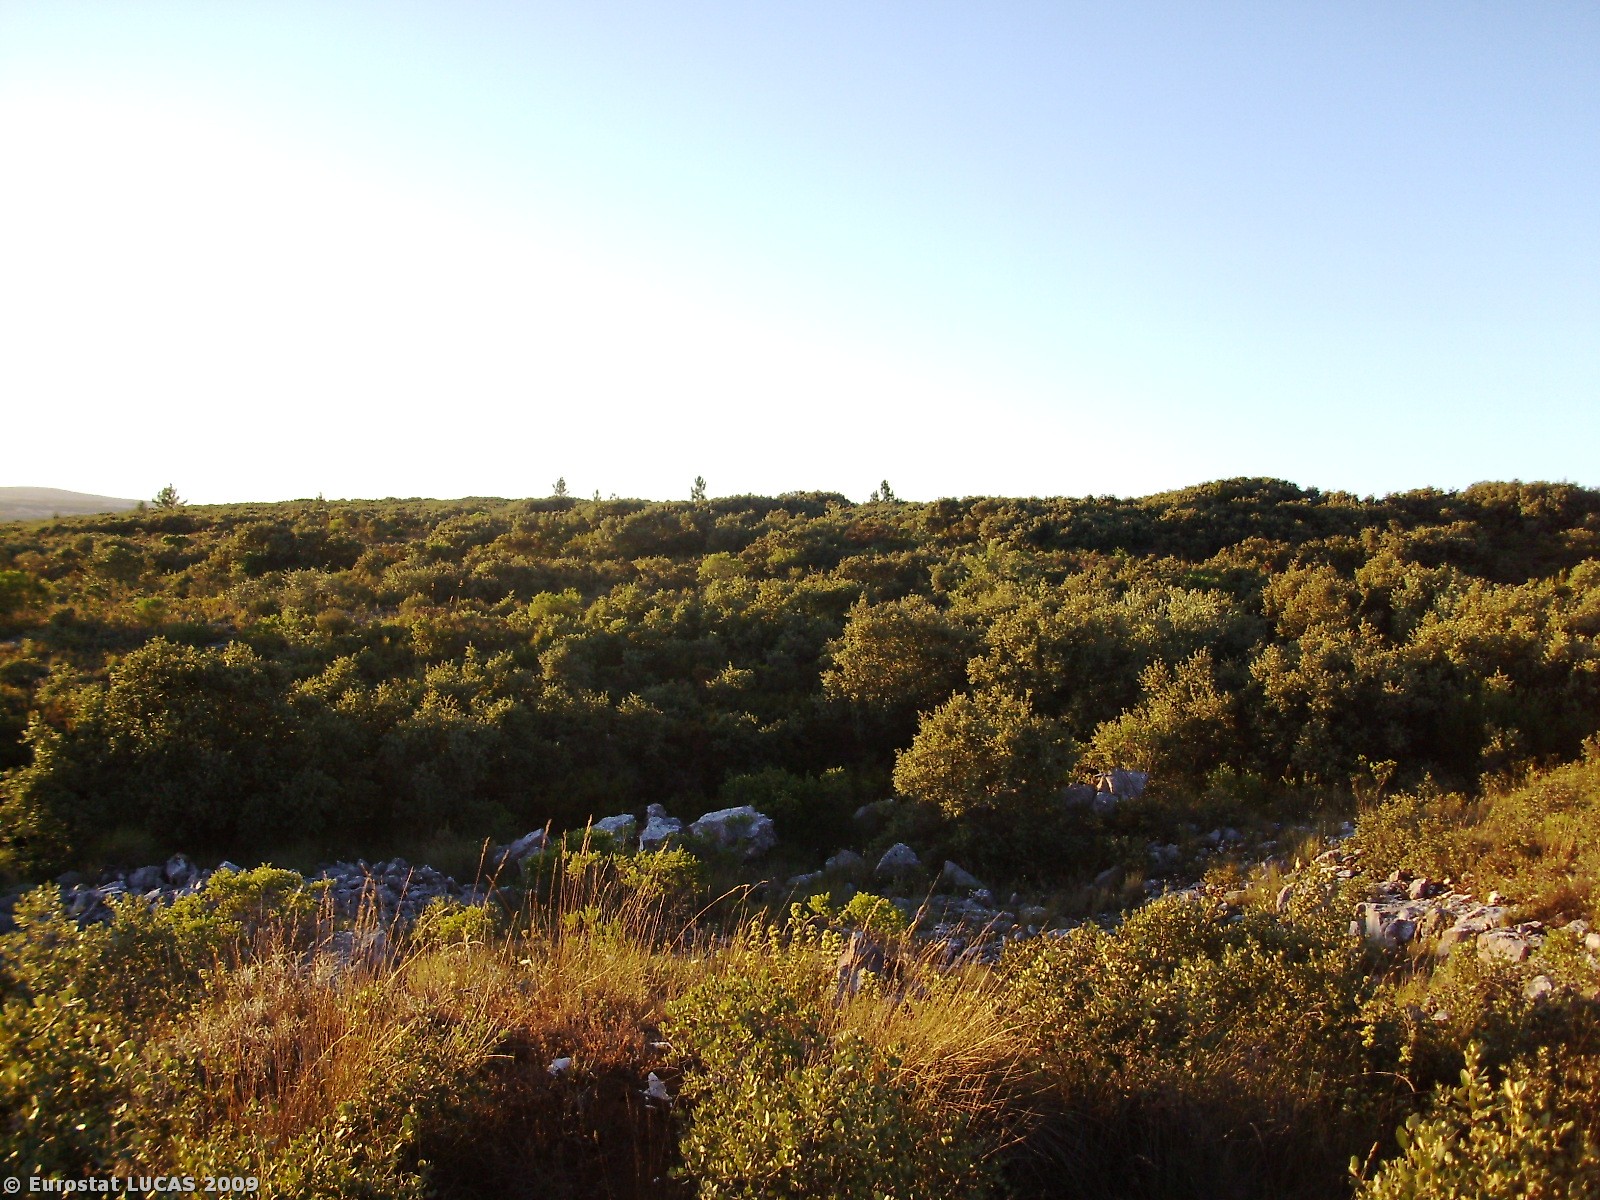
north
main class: Shrubland
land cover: Shrubland without tree cover
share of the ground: > 75 %
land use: Nature reserves
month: July
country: PT
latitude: 39.4671
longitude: -8.8059
